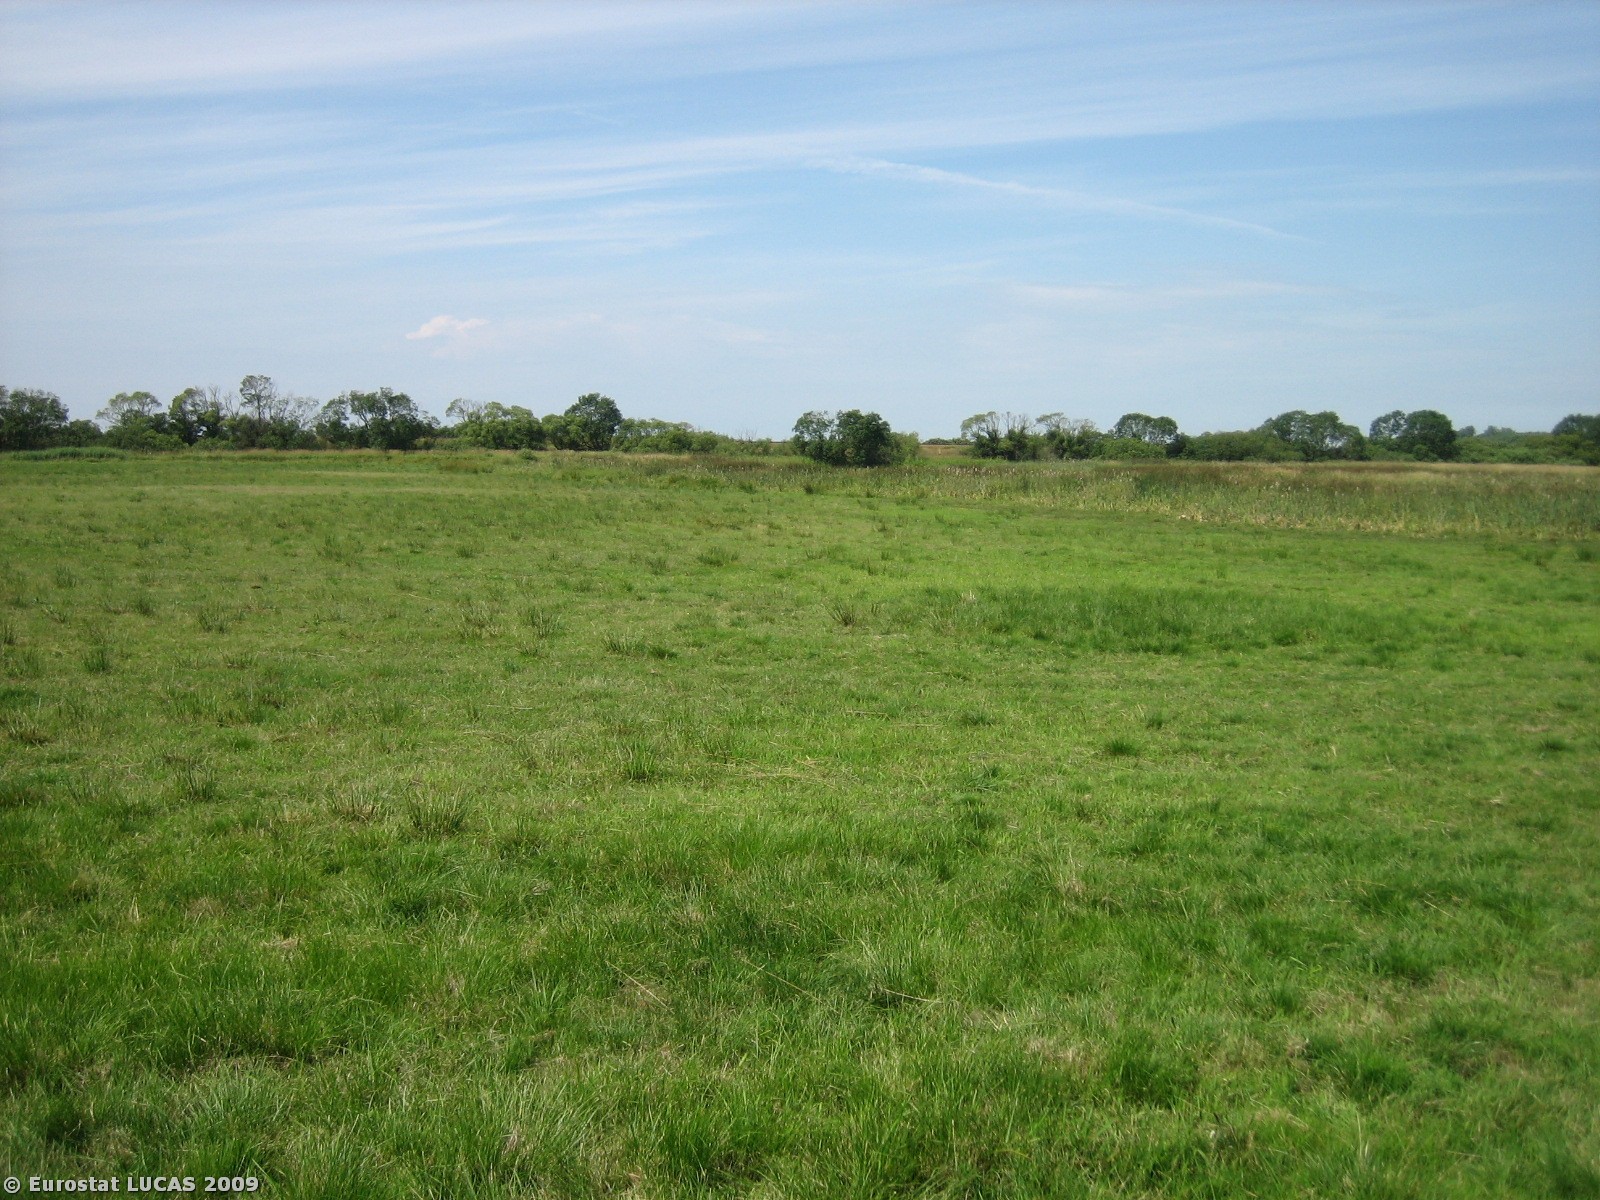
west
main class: Grassland
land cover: Grassland without tree/shrub cover
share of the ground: > 75 %
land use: Nature reserves
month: July
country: DK
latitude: 55.9274
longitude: 8.5131
